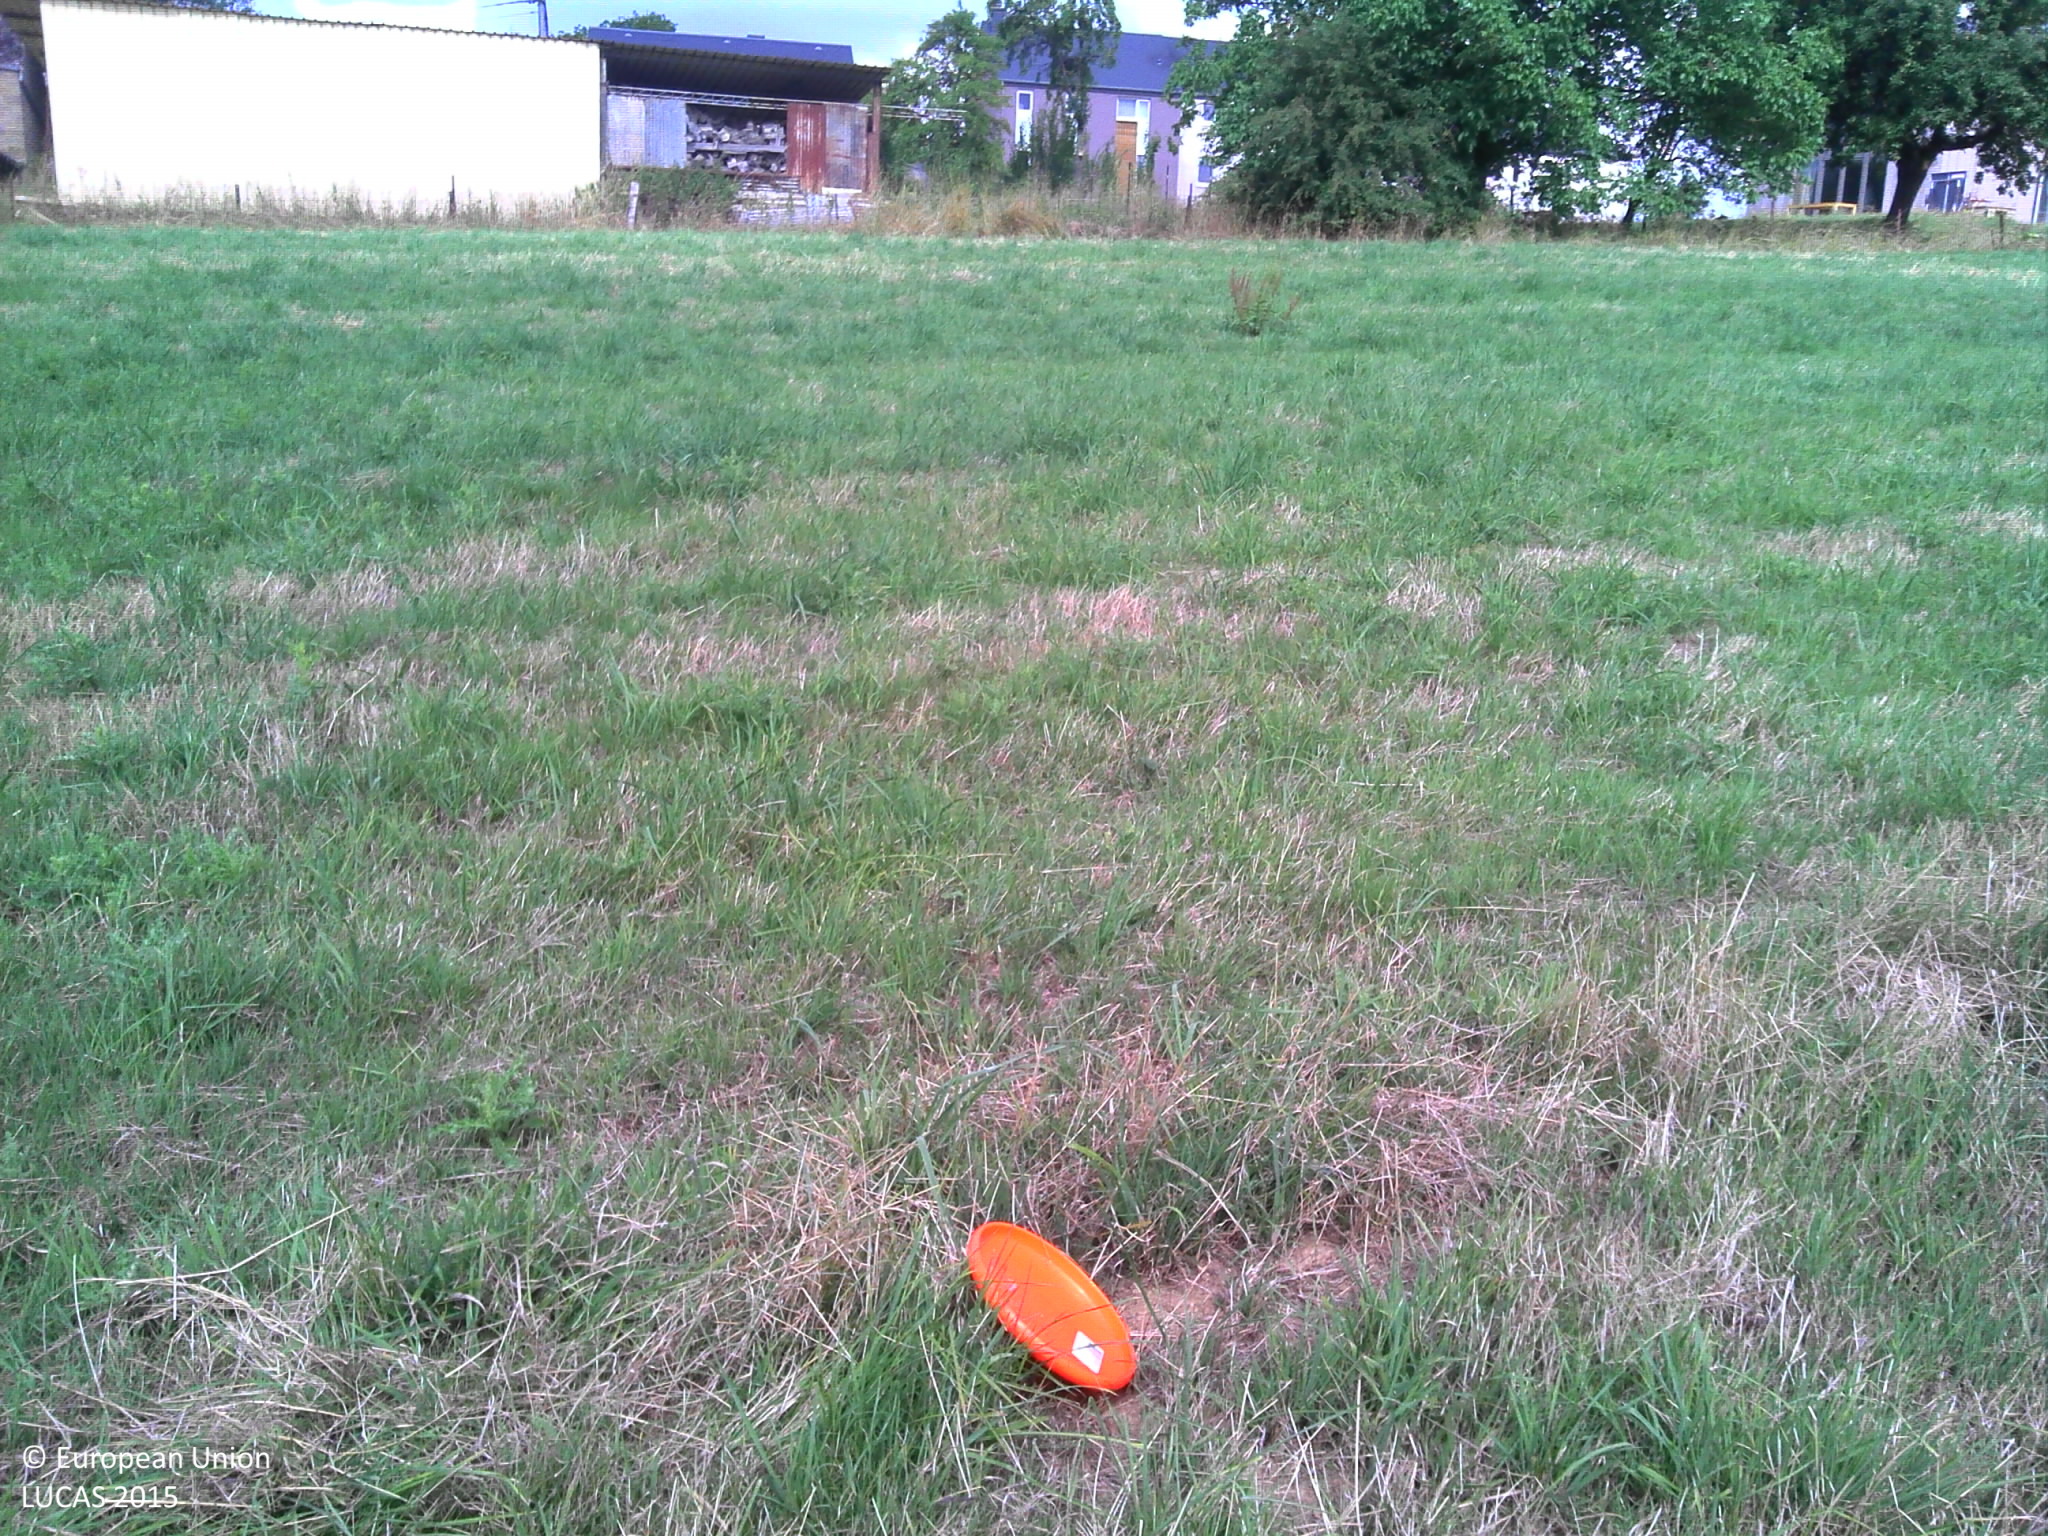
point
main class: Grassland
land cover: Grassland without tree/shrub cover
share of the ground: > 75 %
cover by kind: herbaceous plants 100 %
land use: Agriculture (excluding fallow land and kitchen gardens)
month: July
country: BE
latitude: 49.5407
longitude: 5.5903
